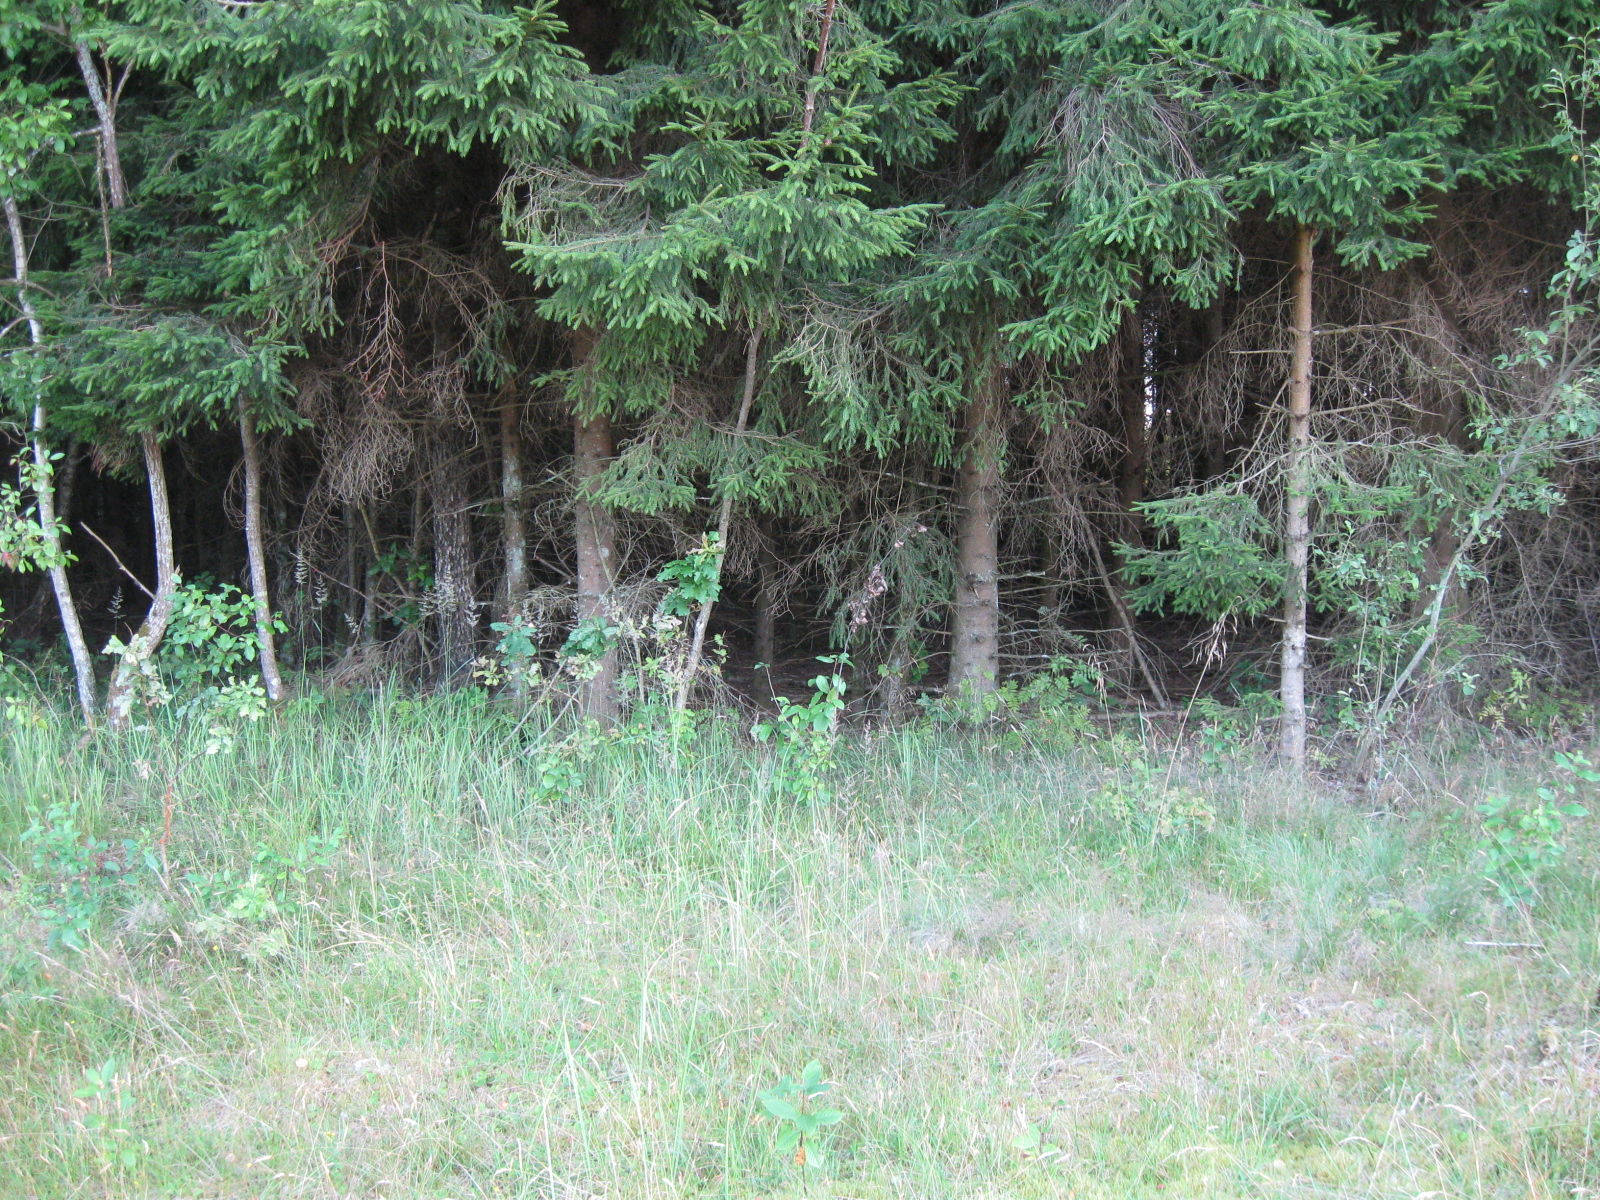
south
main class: Grassland
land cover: Grassland with sparse tree/shrub cover
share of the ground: > 75 %
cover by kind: herbaceous plants 75 %, lichens and mosses 15 %, broadleaved forest trees 5 %, shrubs 5 %
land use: Semi-natural and natural areas not in use
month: August
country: LT
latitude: 54.8184
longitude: 23.4485
